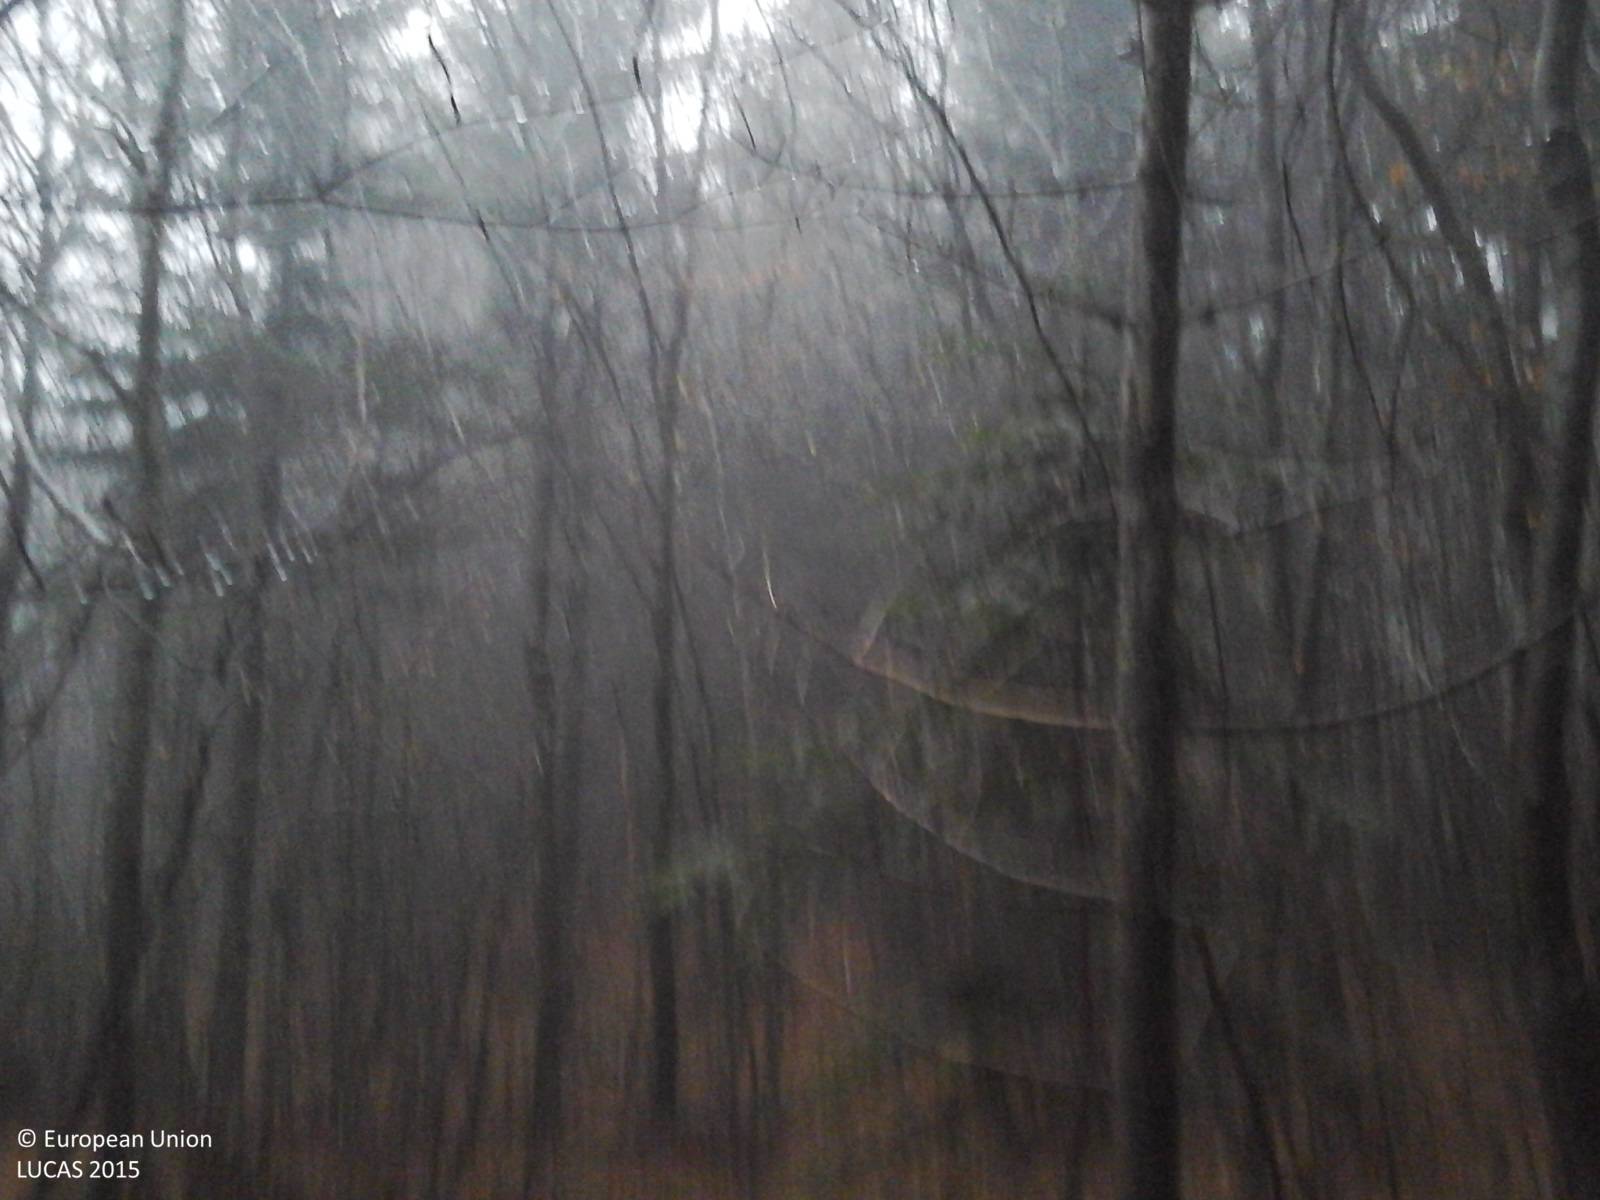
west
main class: Woodland
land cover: Other mixed woodland
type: beech forest
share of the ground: > 75 %
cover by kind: coniferous forest trees 50 %, broadleaved forest trees 50 %
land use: Forestry
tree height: > 5 m
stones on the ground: < 10 %
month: January
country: IT
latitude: 44.2962
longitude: 10.2126
